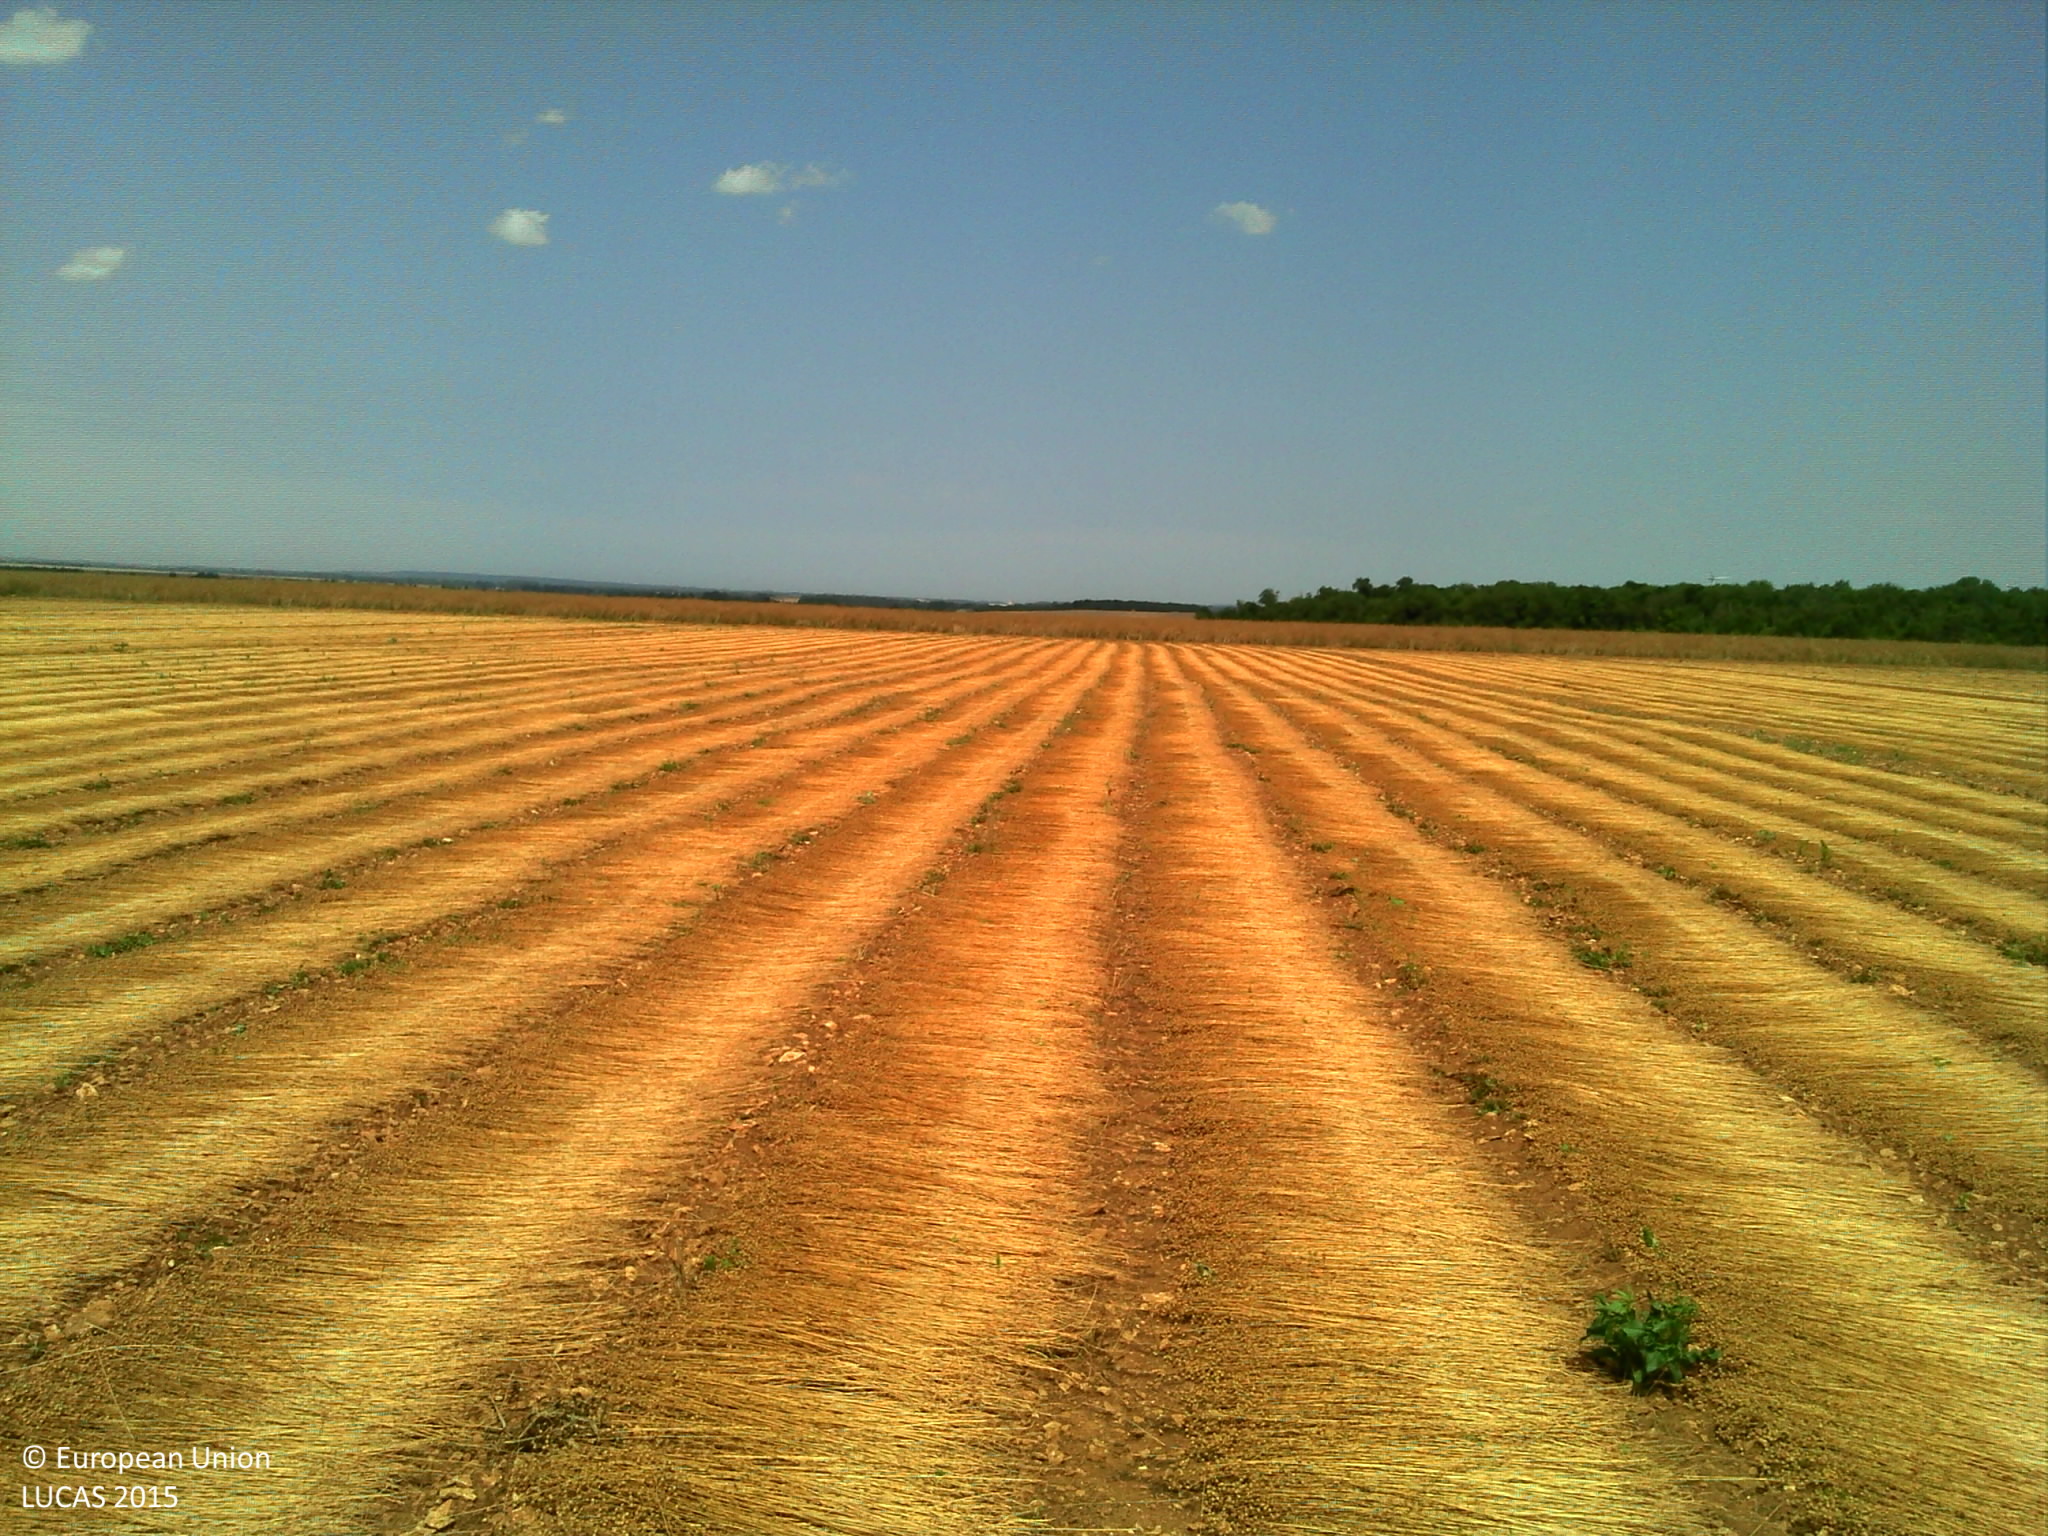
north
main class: Cropland
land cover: Other fibre and oleaginous crops
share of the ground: > 75 %
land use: Agriculture (excluding fallow land and kitchen gardens)
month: July
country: FR
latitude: 49.0370
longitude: -0.1963
